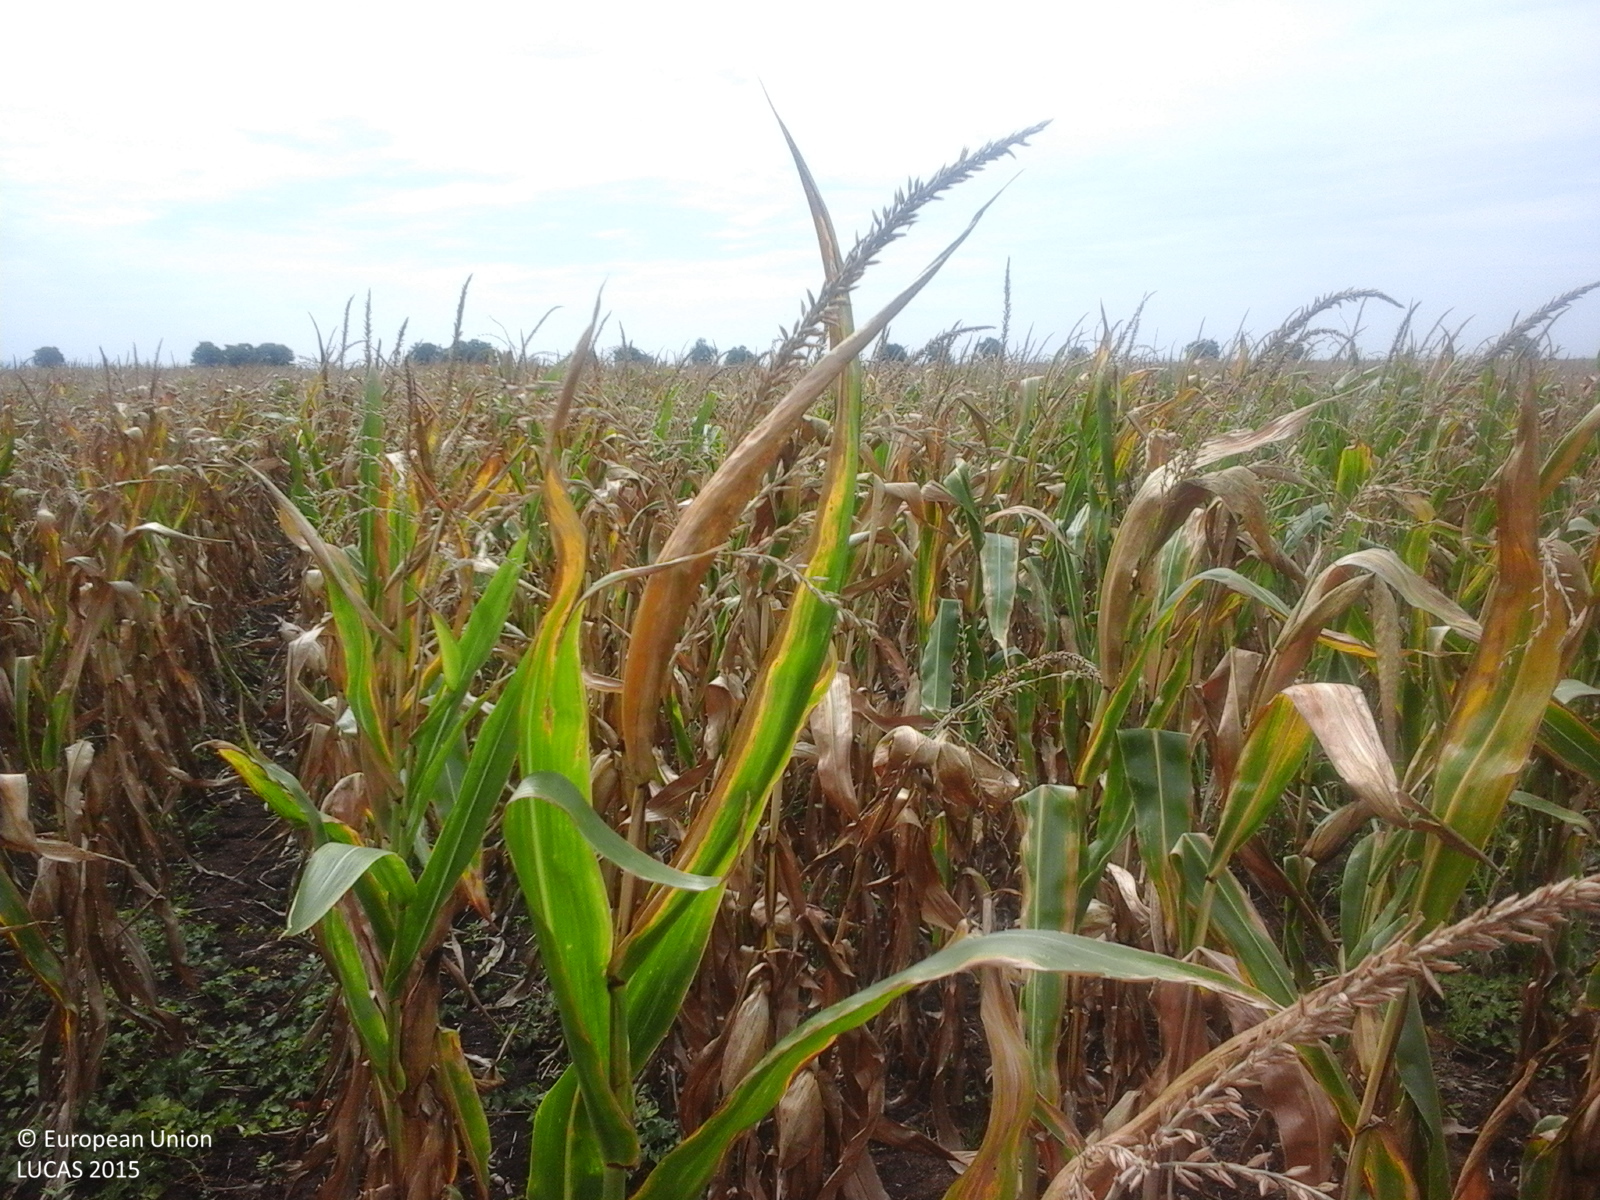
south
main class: Cropland
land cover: Maize
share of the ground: > 75 %
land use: Agriculture (excluding fallow land and kitchen gardens)
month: August
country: RO
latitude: 46.3431
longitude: 21.5362
